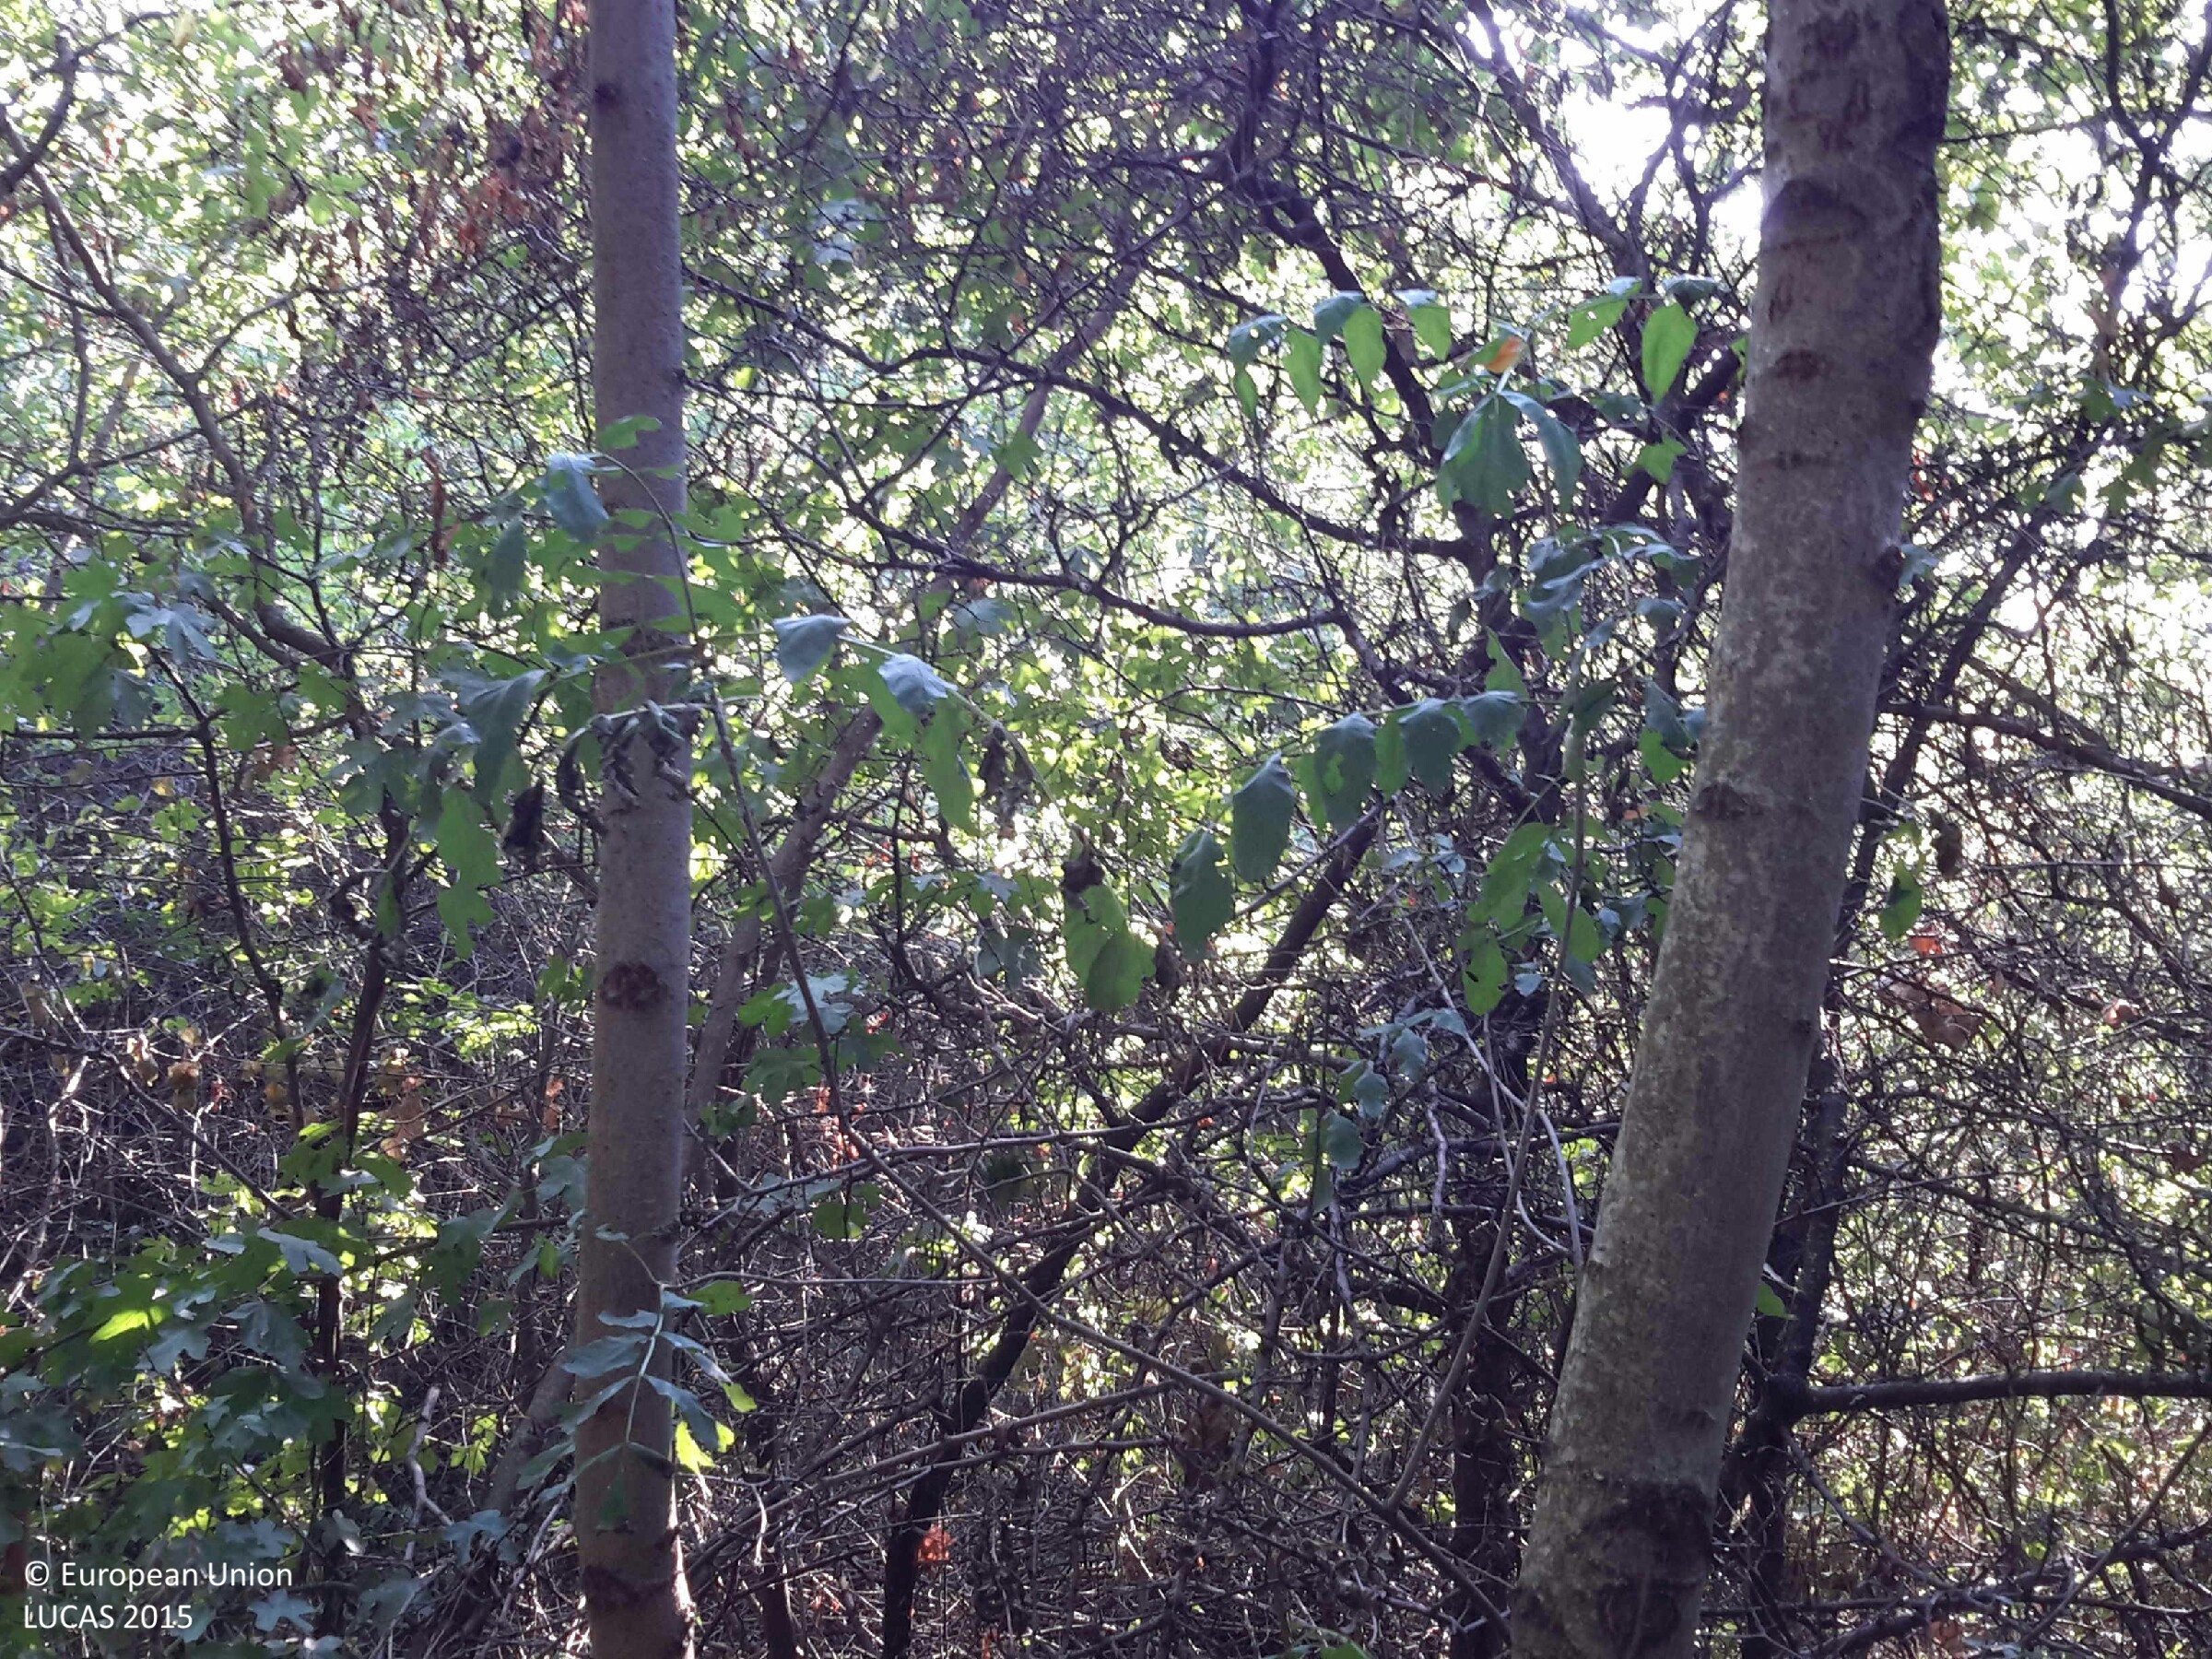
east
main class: Woodland
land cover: Broadleaved woodland
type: mesophytic deciduous forest
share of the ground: > 75 %
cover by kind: broadleaved forest trees 90 %, shrubs 5 %, herbaceous plants 5 %
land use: Forestry
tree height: > 5 m
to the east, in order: Broadleaved woodland; Maize; Common wheat
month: August
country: HU
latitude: 47.9196
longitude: 17.1400
